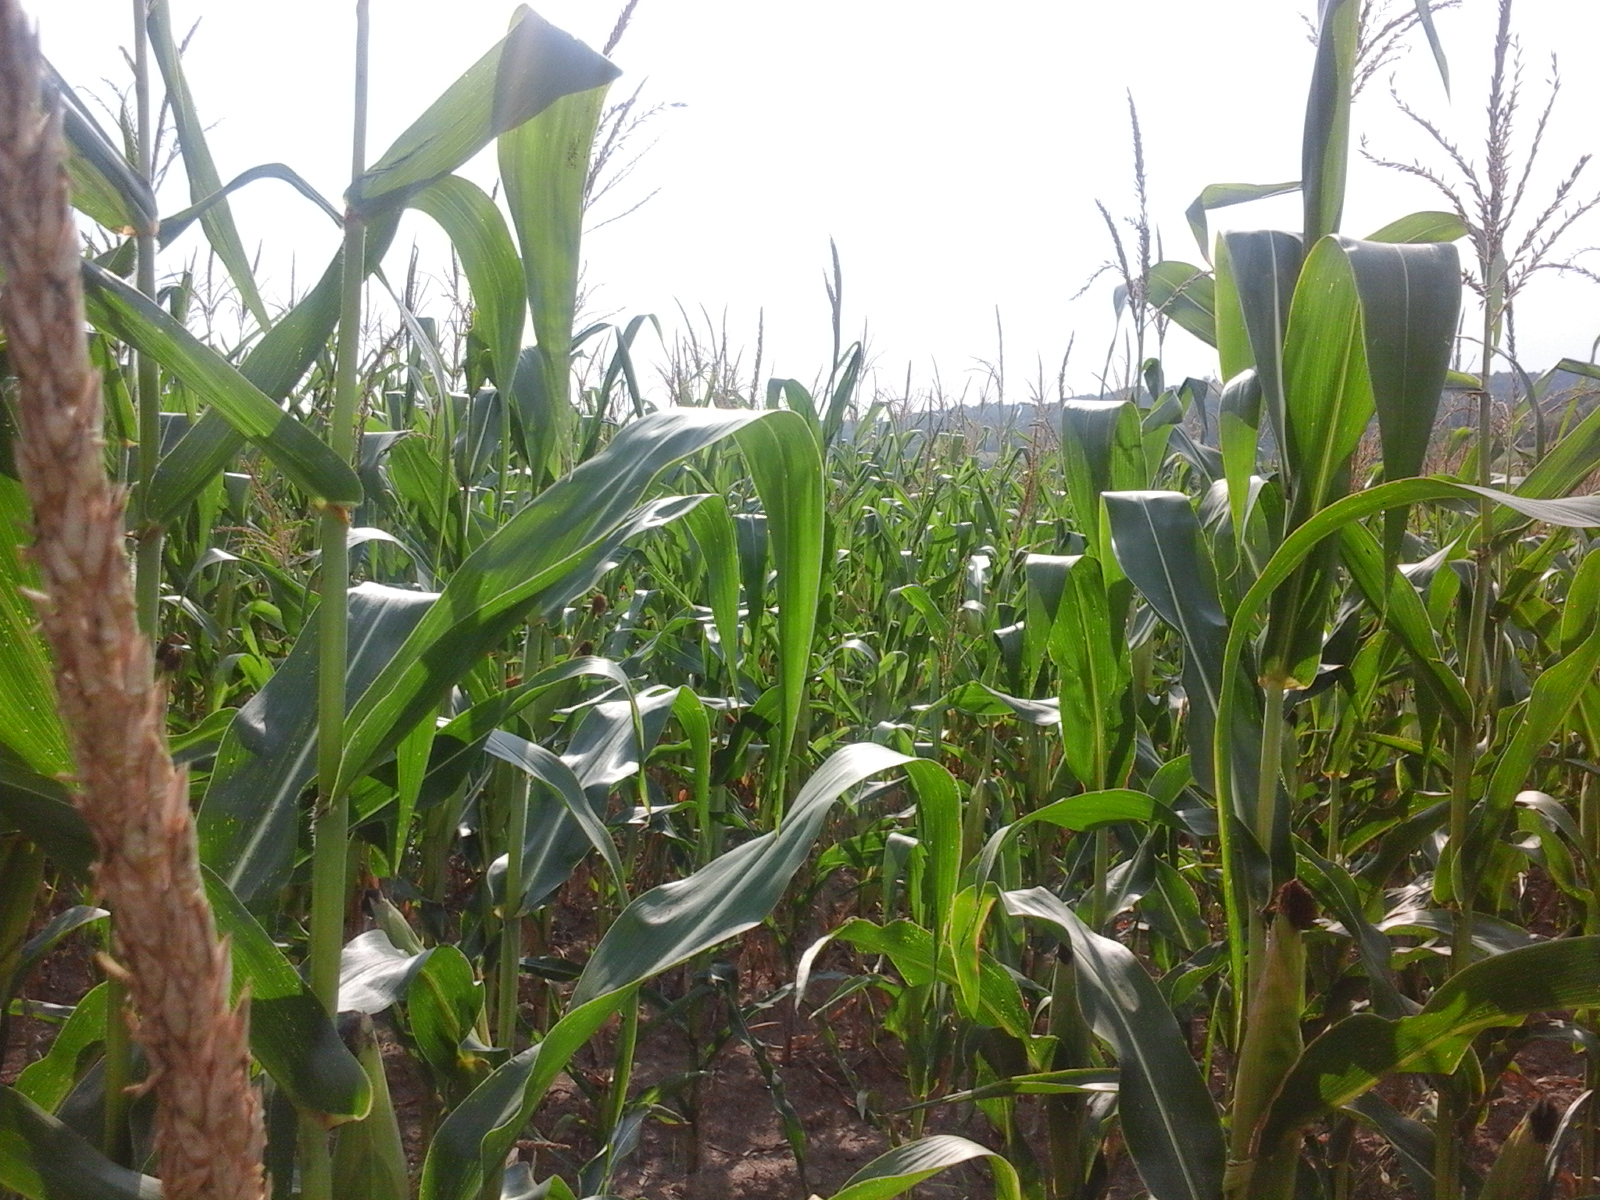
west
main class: Cropland
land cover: Maize
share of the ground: > 75 %
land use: Agriculture (excluding fallow land and kitchen gardens)
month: August
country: RO
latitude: 44.8037
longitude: 23.7264
